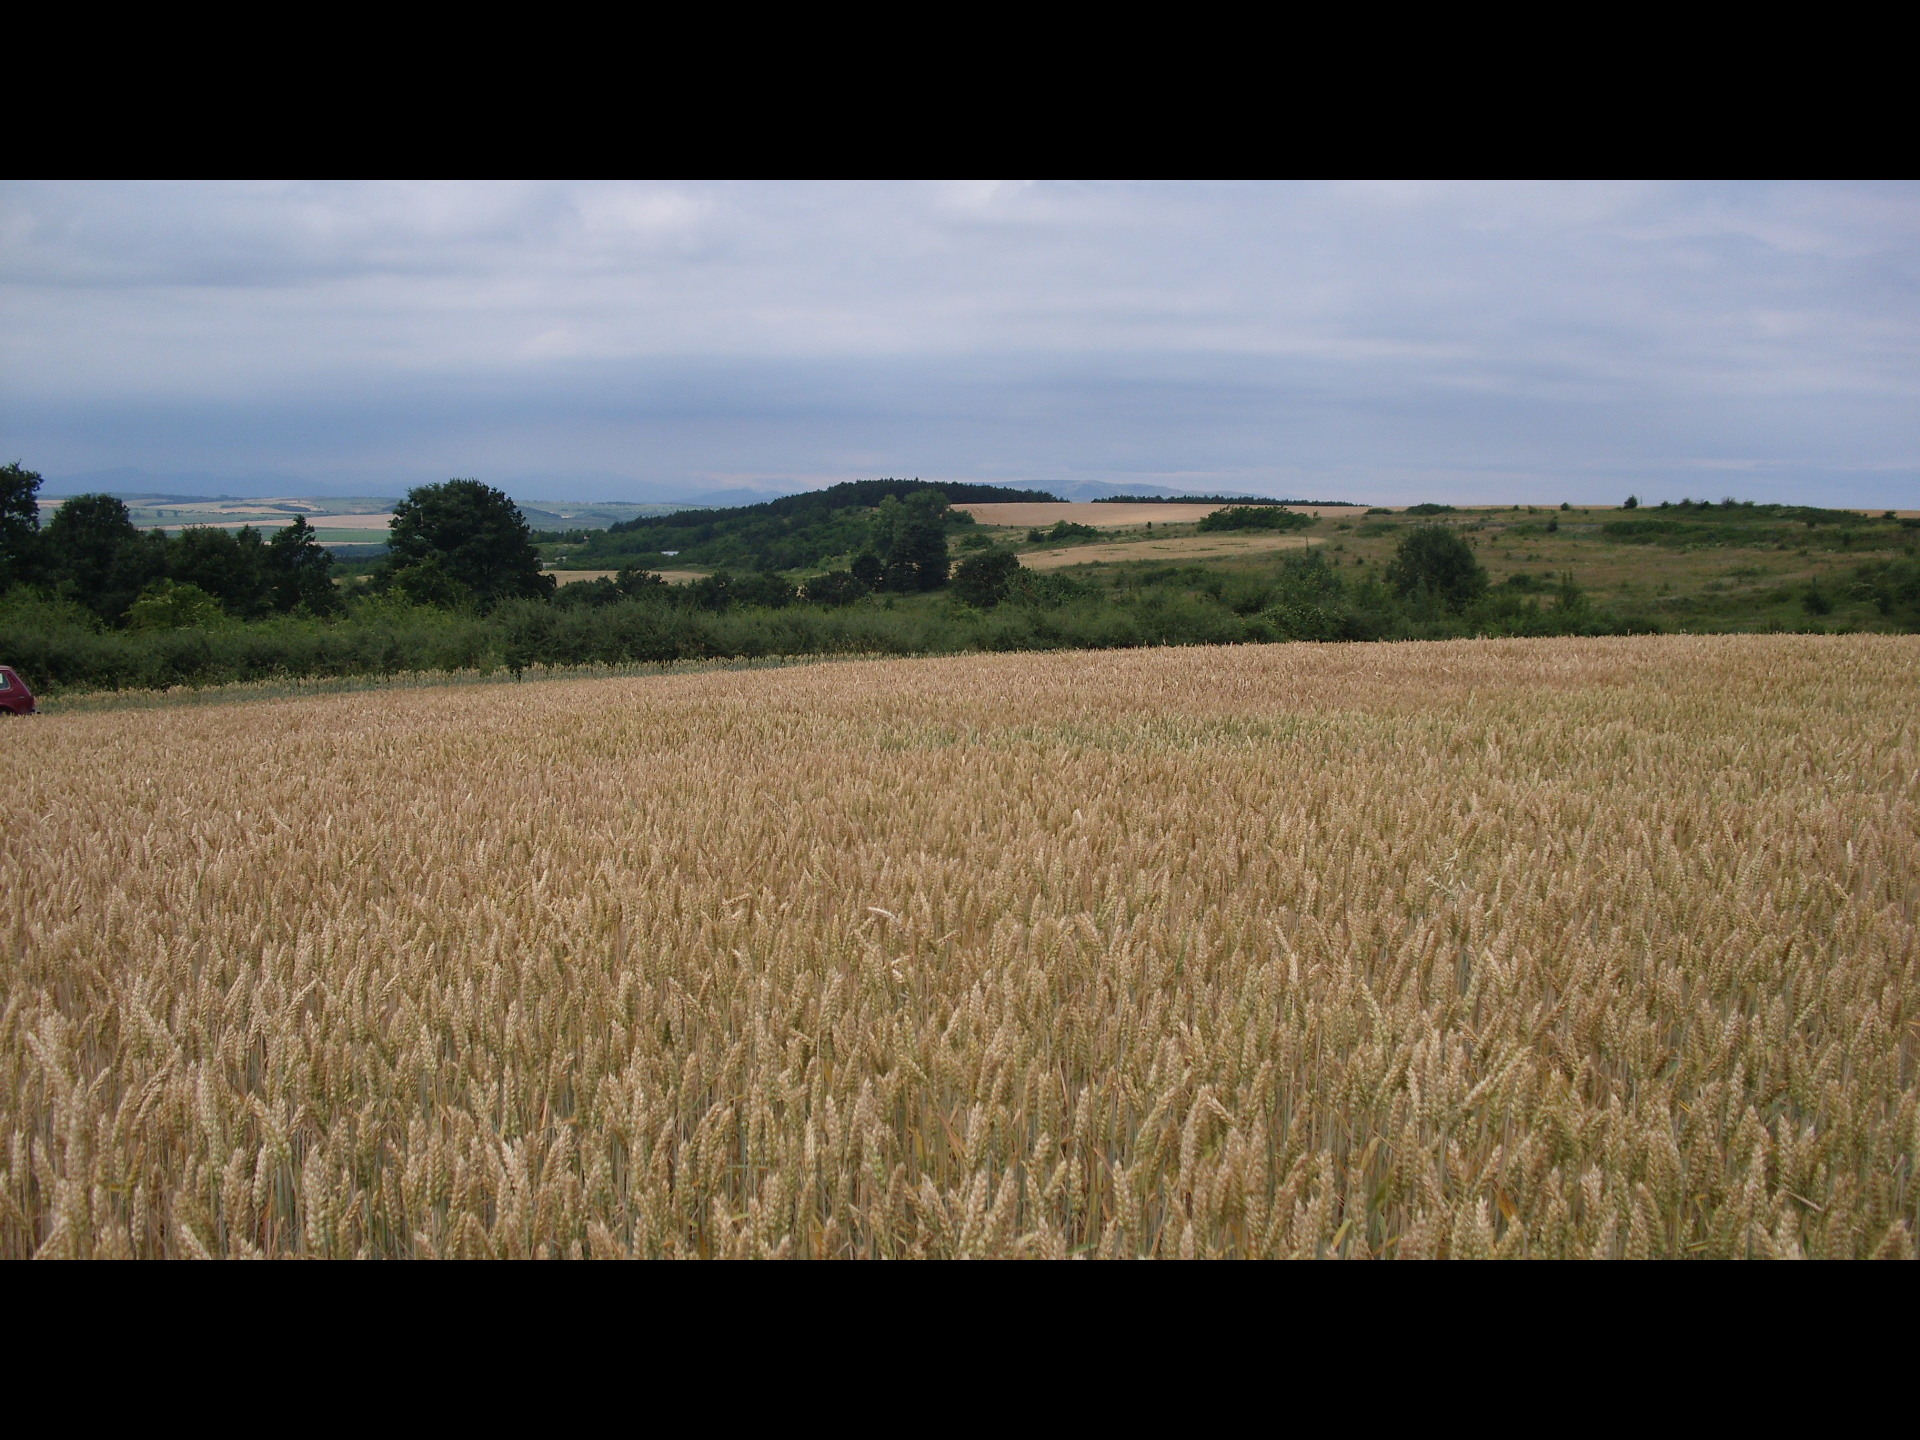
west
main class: Cropland
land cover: Common wheat
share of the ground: > 75 %
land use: Agriculture (excluding fallow land and kitchen gardens)
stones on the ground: < 10 %
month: June
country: BG
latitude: 43.3713
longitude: 23.5079
